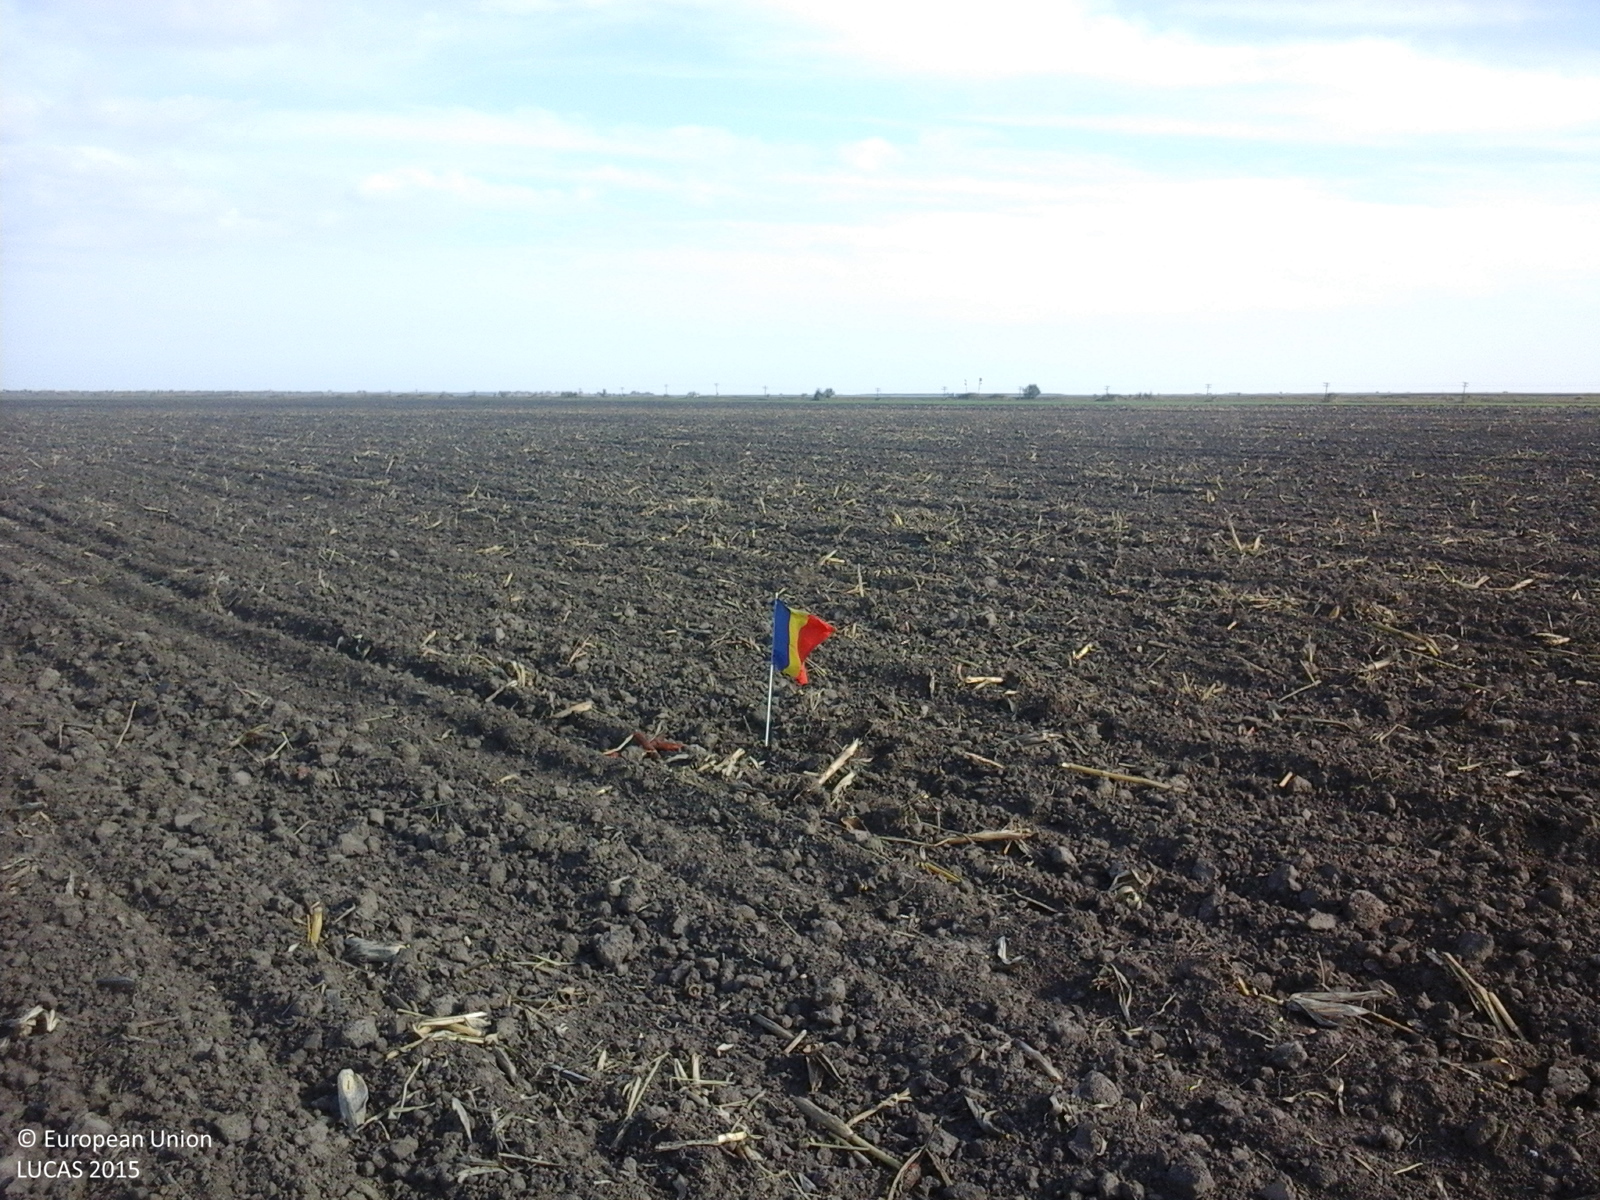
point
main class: Cropland
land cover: Maize
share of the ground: < 10 %
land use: Agriculture (excluding fallow land and kitchen gardens)
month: October
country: RO
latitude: 45.3879
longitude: 27.2997
